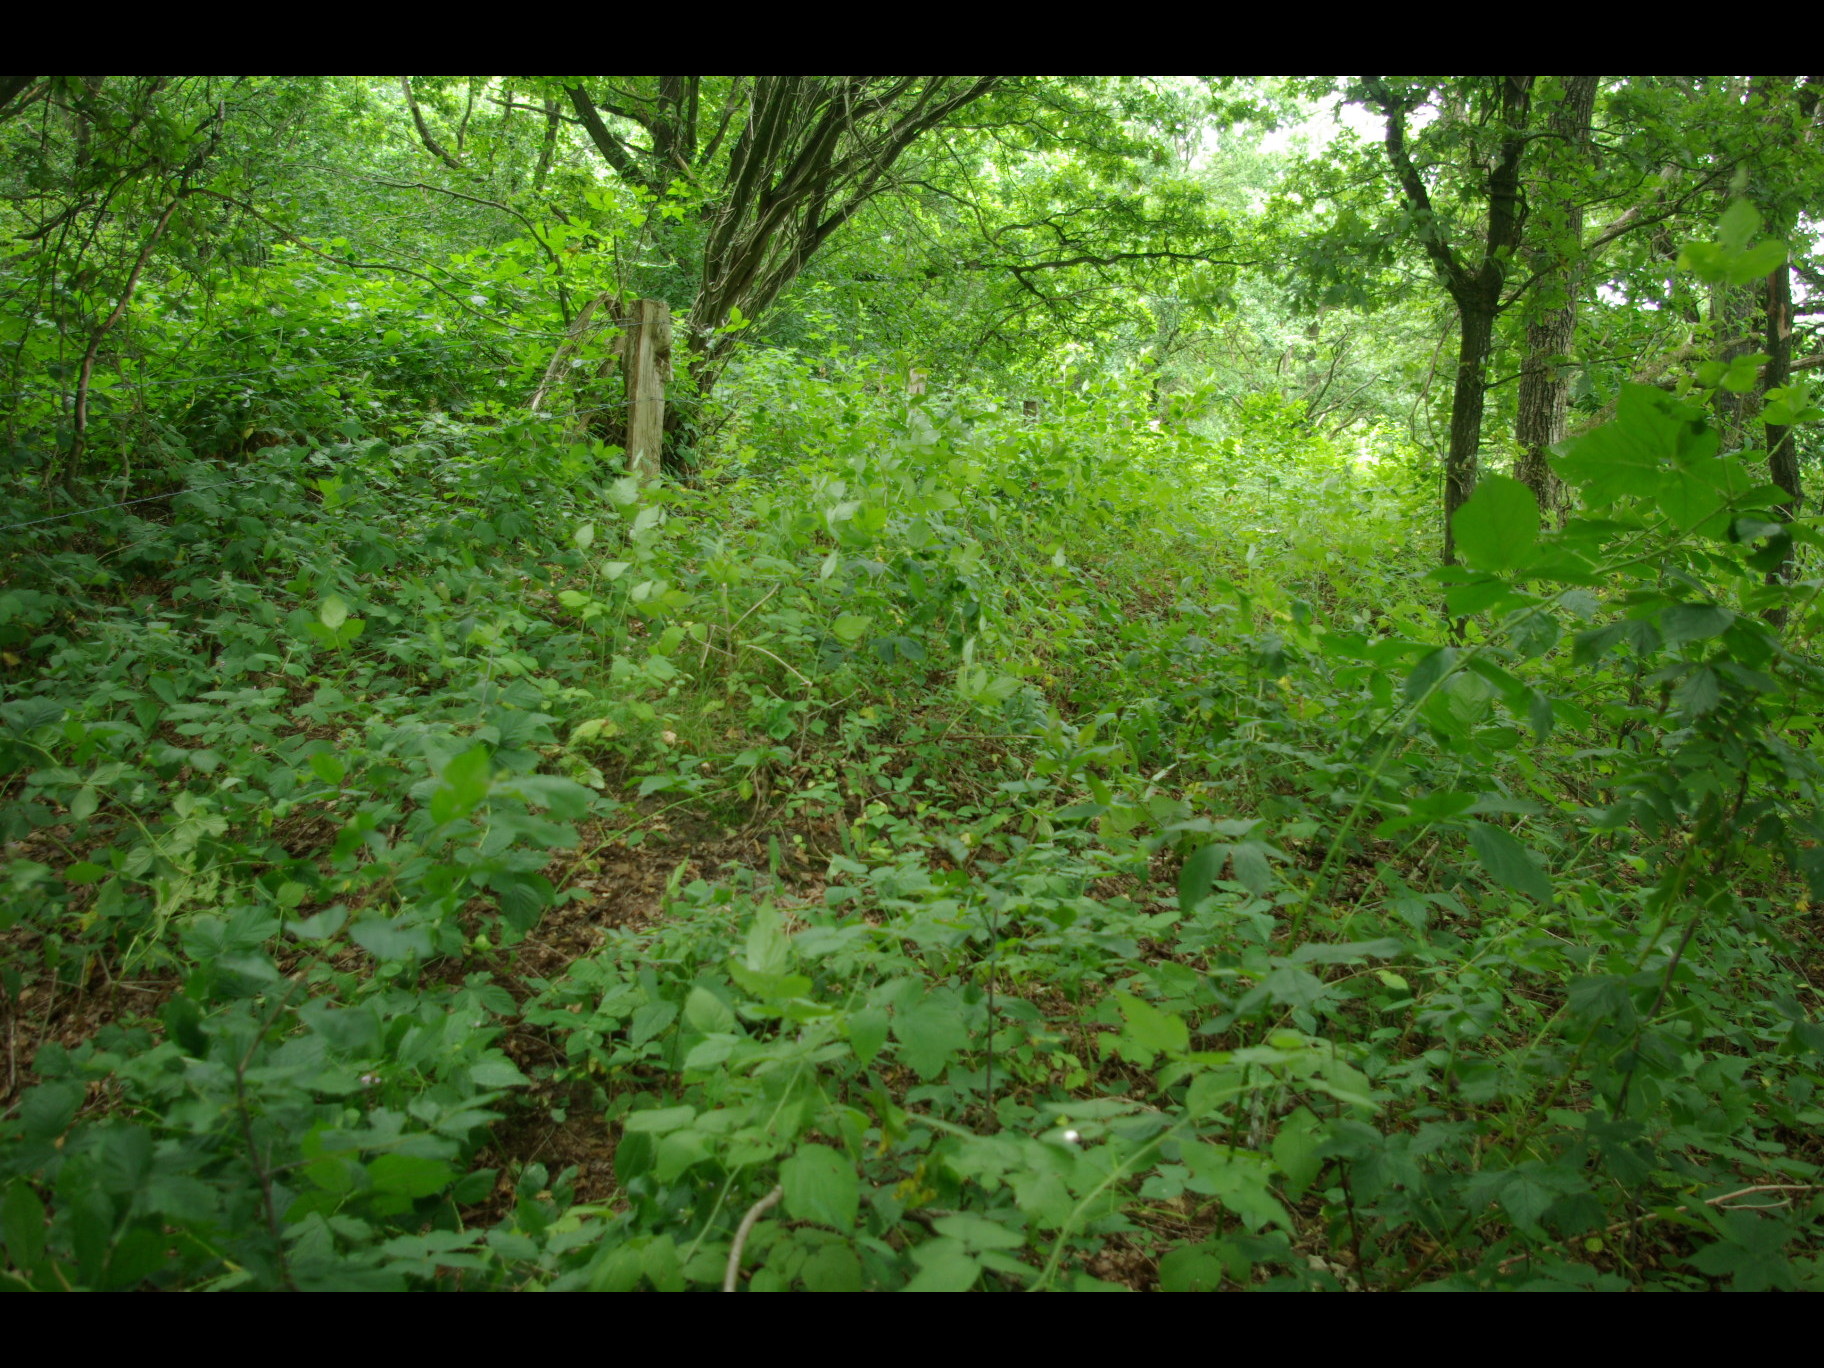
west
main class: Woodland
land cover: Broadleaved woodland
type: mesophytic deciduous forest
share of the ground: > 75 %
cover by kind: broadleaved forest trees 80 %, shrubs 10 %, herbaceous plants 10 %
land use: Semi-natural and natural areas not in use
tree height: > 5 m
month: August
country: DE
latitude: 54.6219
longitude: 9.2726
